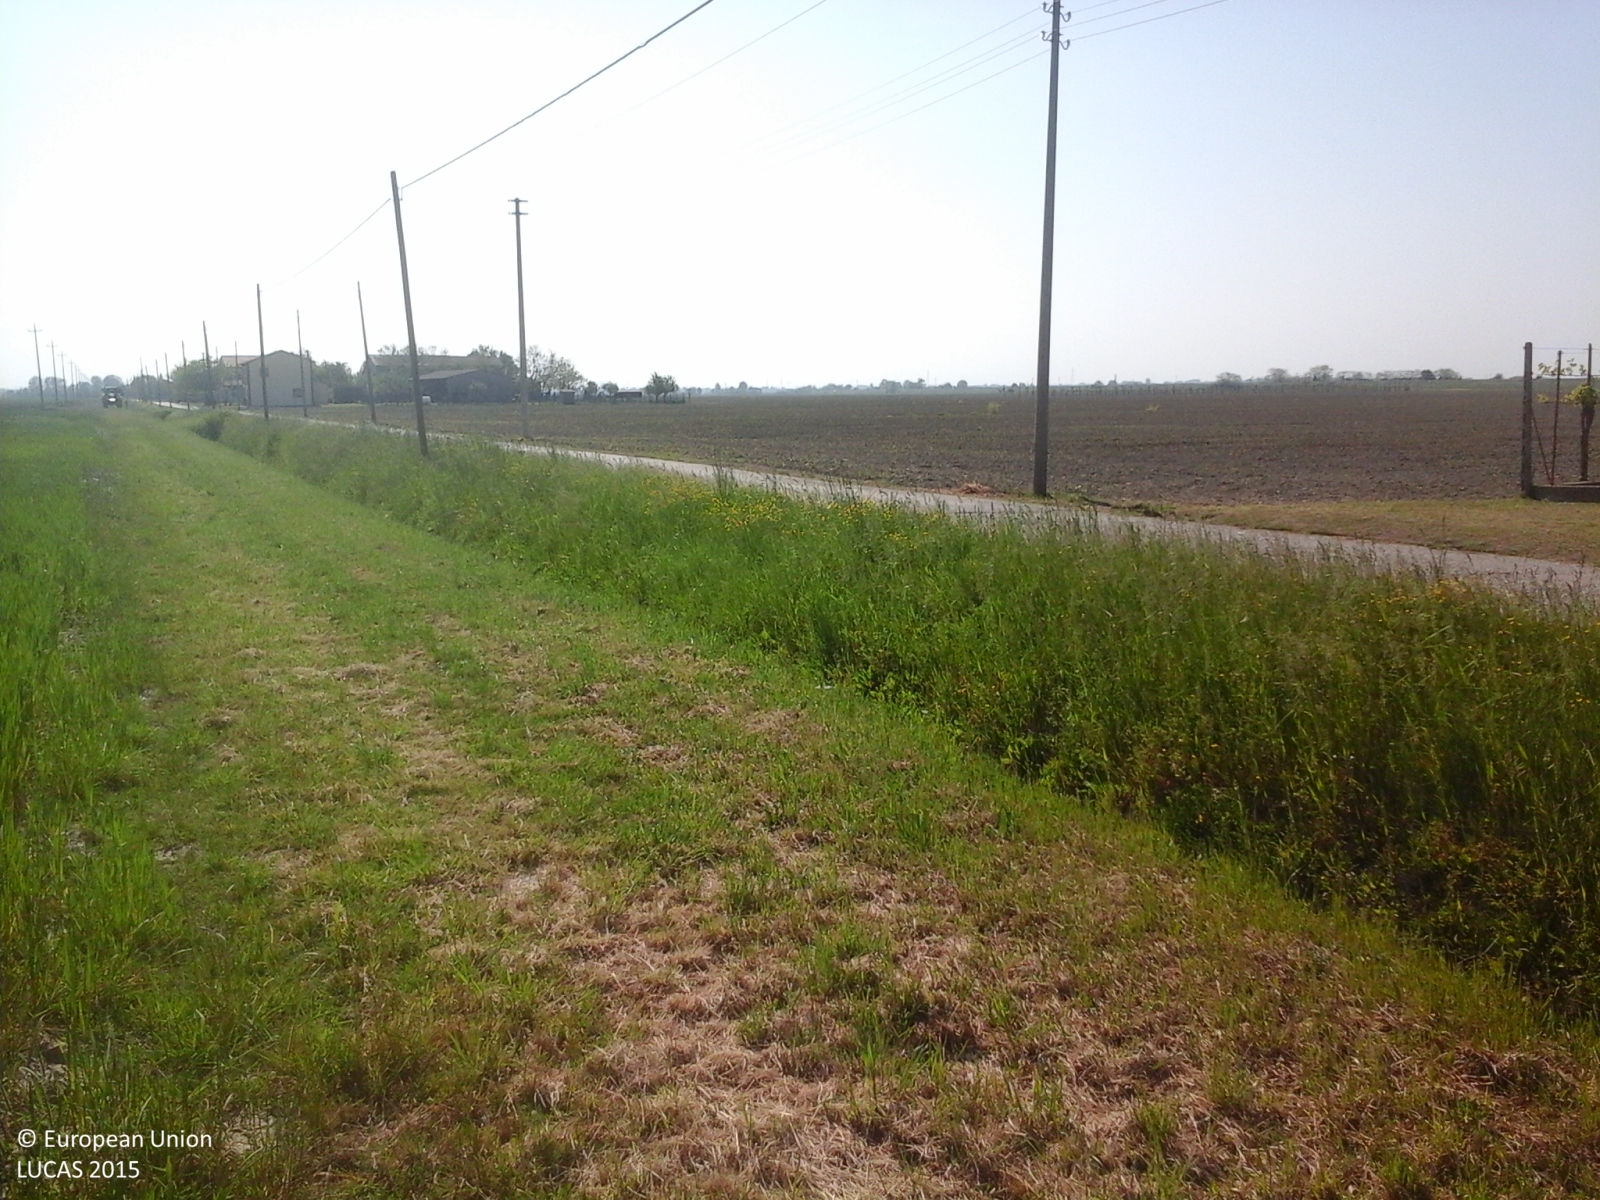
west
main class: Cropland
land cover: Common wheat
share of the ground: > 75 %
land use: Agriculture (excluding fallow land and kitchen gardens)
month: April
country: IT
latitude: 45.0287
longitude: 12.2932
